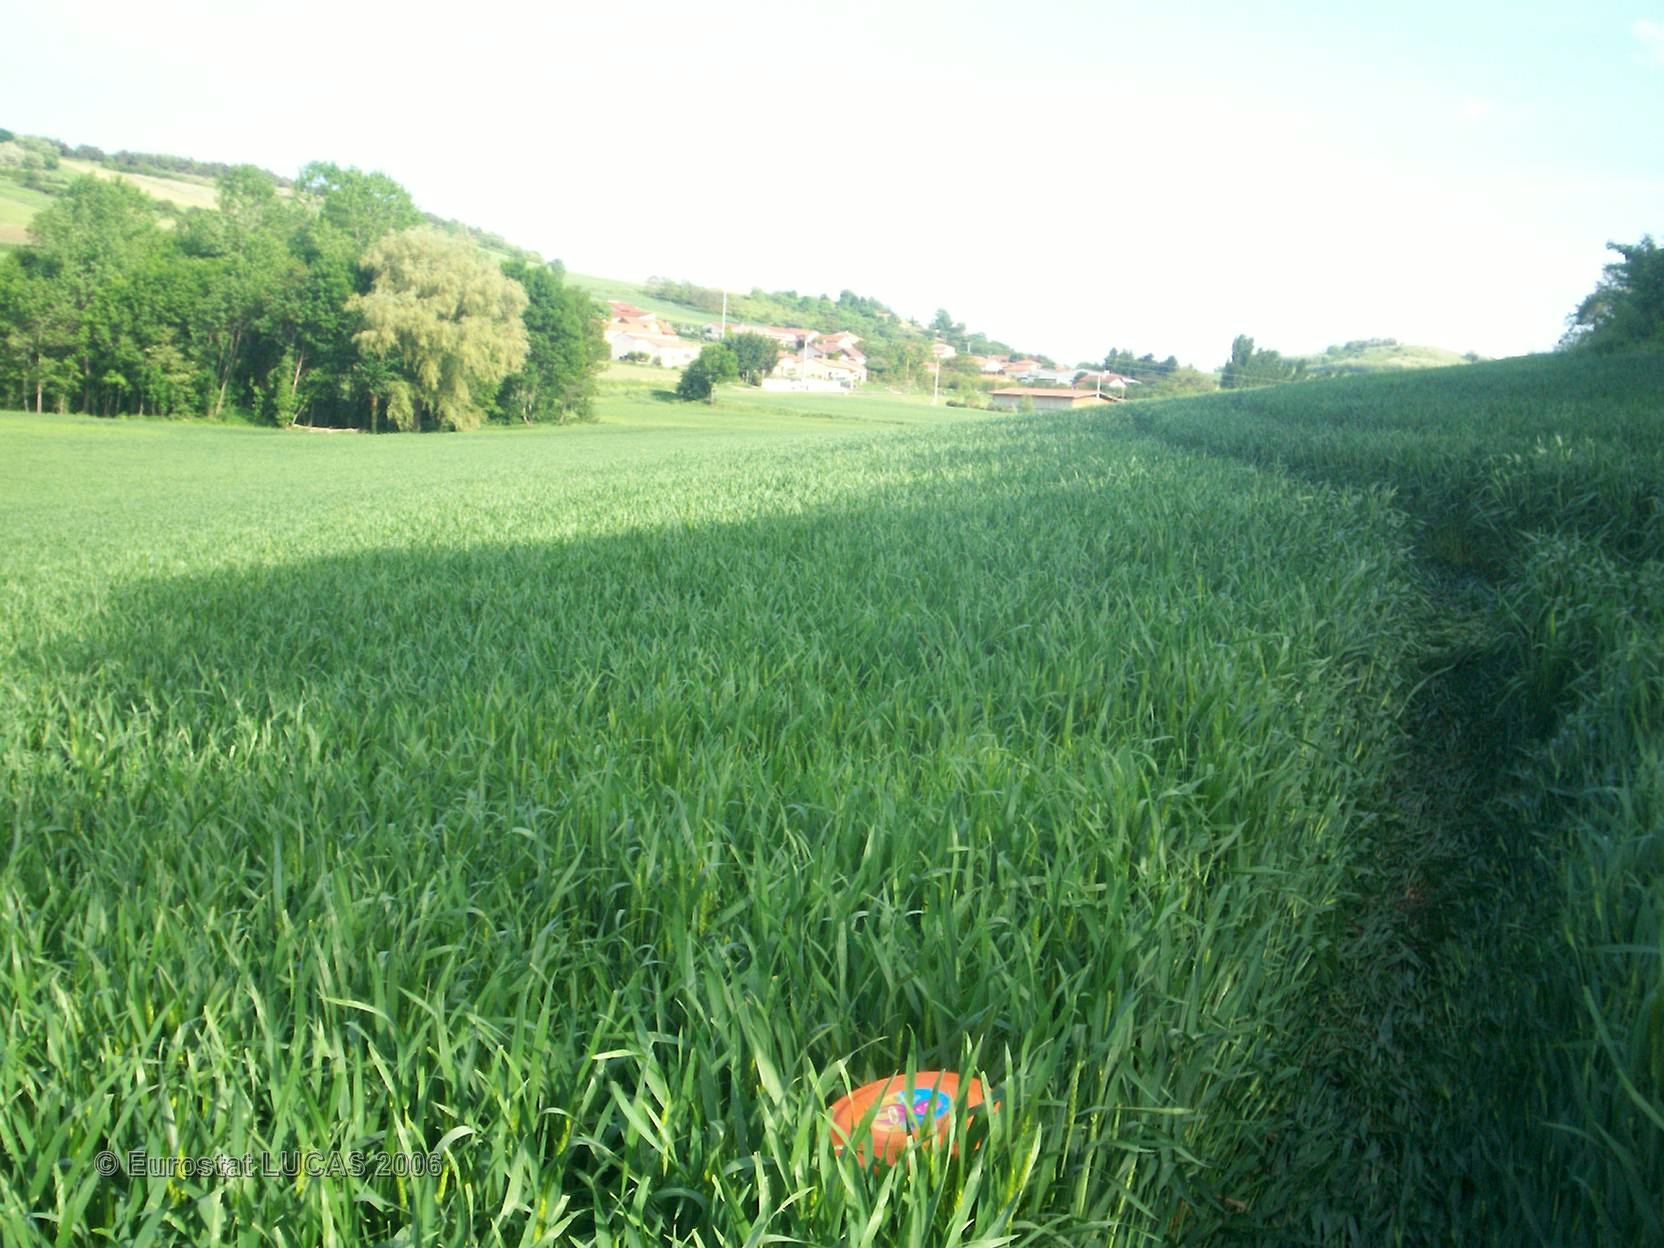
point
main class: Cropland
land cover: Triticale
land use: Agriculture (excluding fallow land and kitchen gardens)
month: May
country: FR
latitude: 45.7600
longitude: 3.2762
